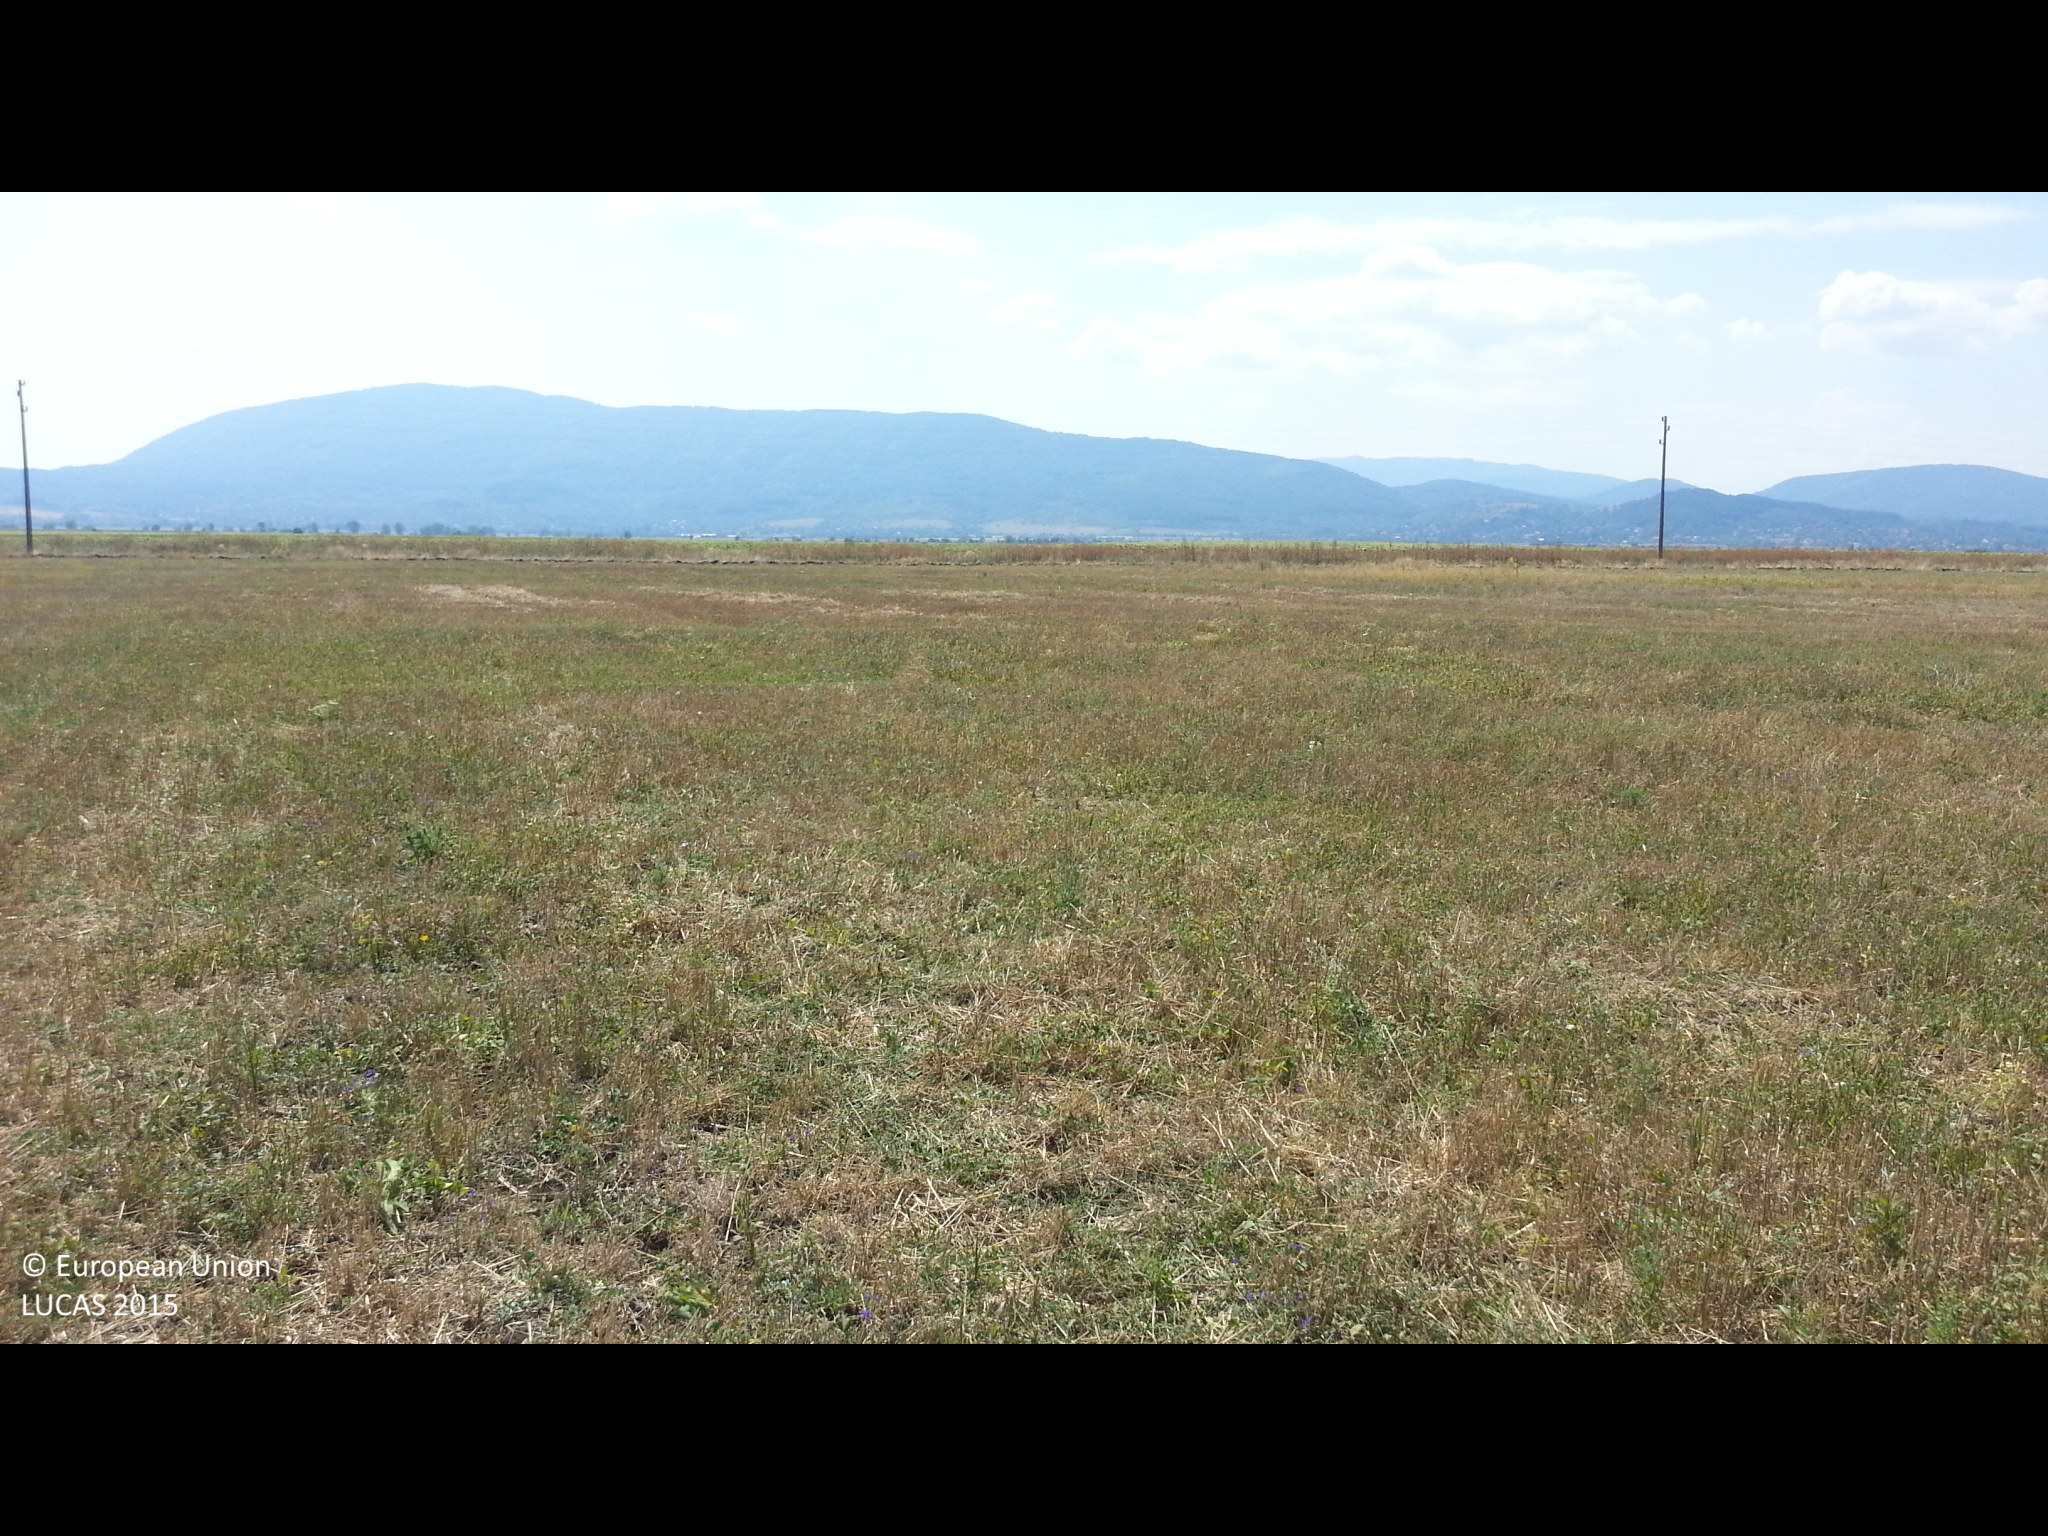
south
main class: Cropland
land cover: Common wheat
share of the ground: > 75 %
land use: Agriculture (excluding fallow land and kitchen gardens)
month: August
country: BG
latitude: 42.4608
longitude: 22.9293
